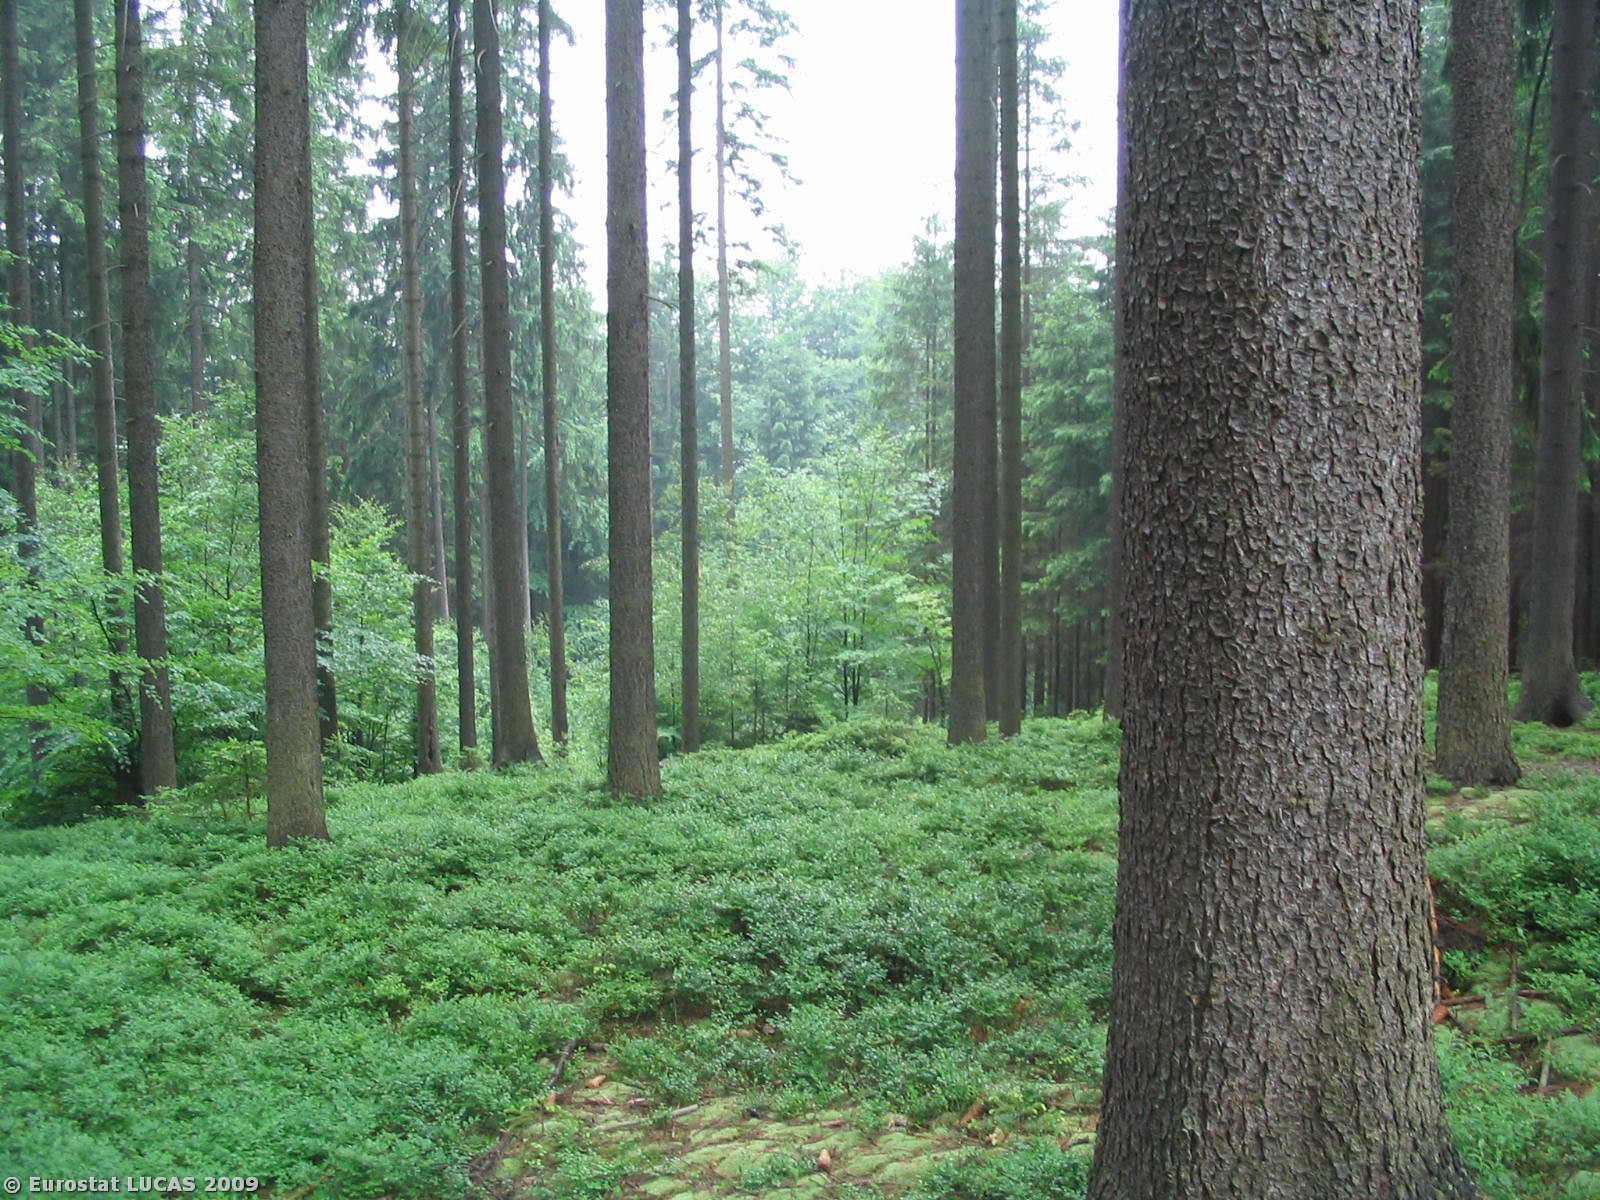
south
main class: Woodland
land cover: Coniferous woodland
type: hemiboreal forest and nemoral coniferous forest and mixed broadleaved-coniferous forest
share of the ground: > 75 %
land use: Forestry
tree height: > 5 m
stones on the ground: < 10 %
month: June
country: CZ
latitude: 49.5049
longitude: 18.7339
